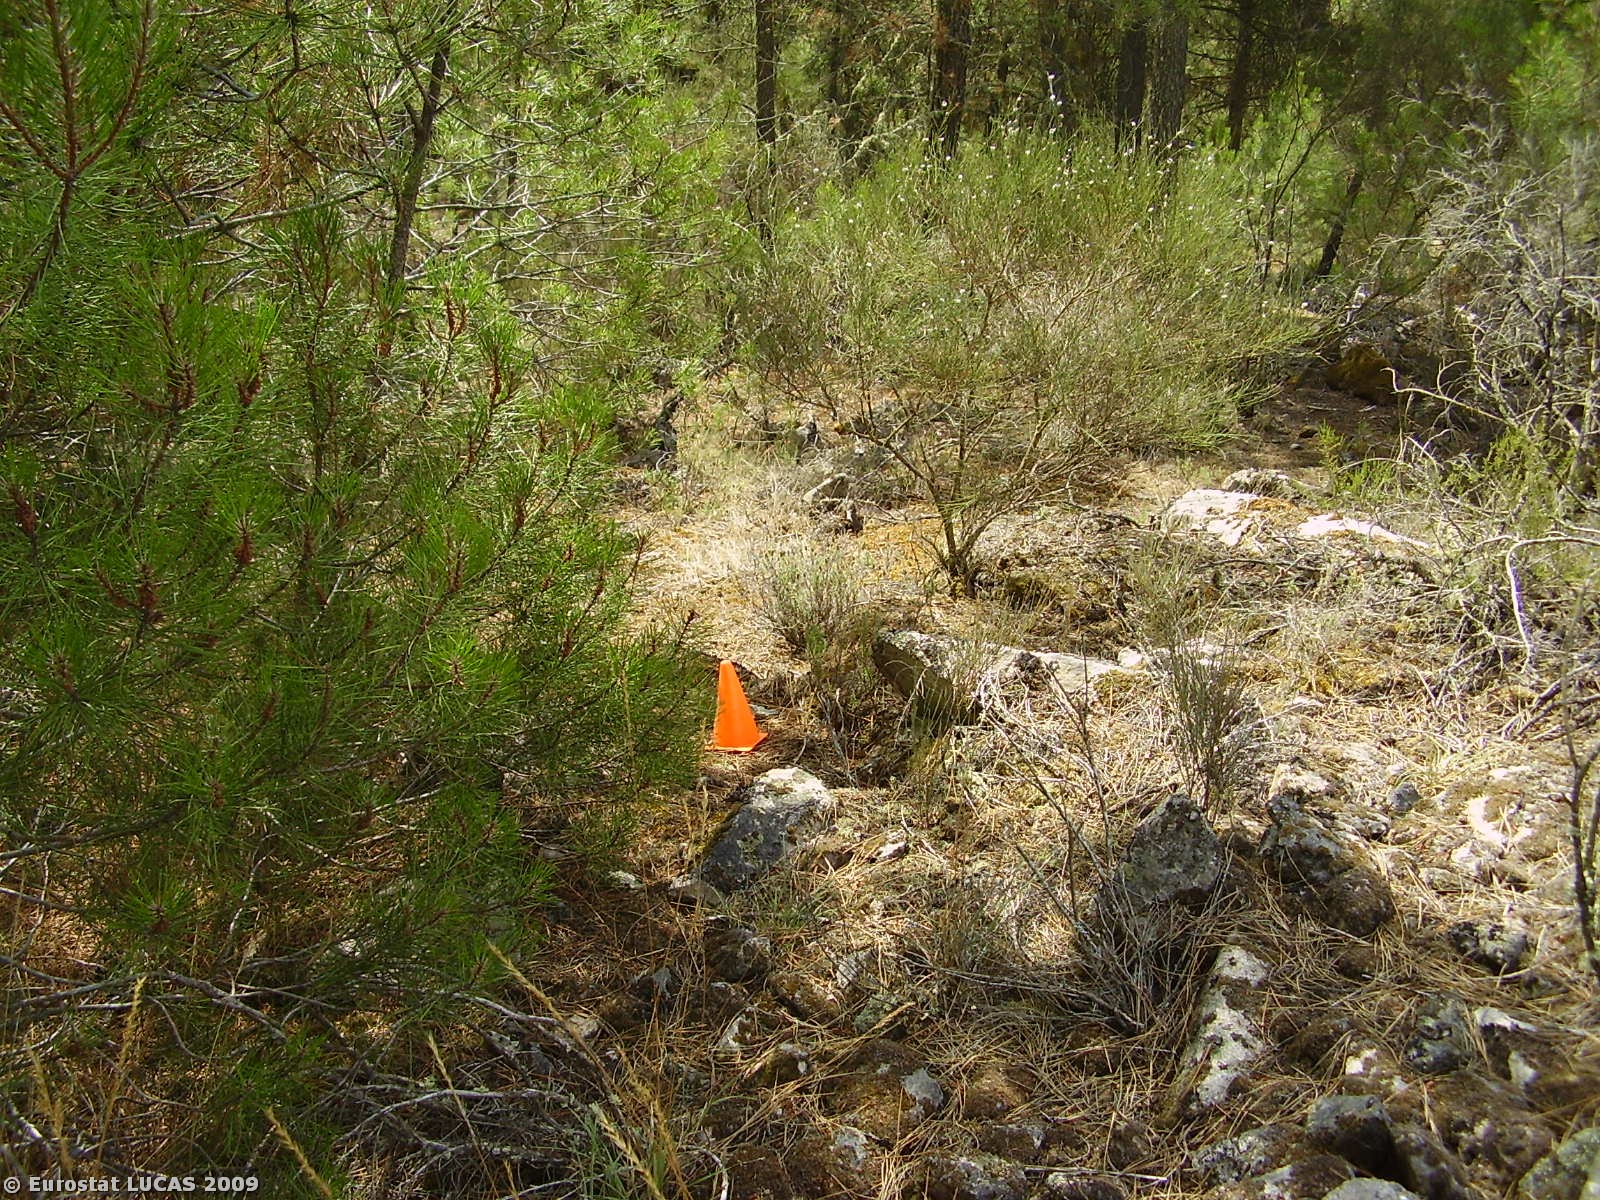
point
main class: Woodland
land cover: Coniferous woodland
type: coniferous forest of the mediterranean region
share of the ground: 10 - 25 %
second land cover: Shrubland with sparse tree cover
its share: < 10 %
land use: Forestry
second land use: Unused
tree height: > 5 m
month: July
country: PT
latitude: 41.3666
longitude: -7.5447
